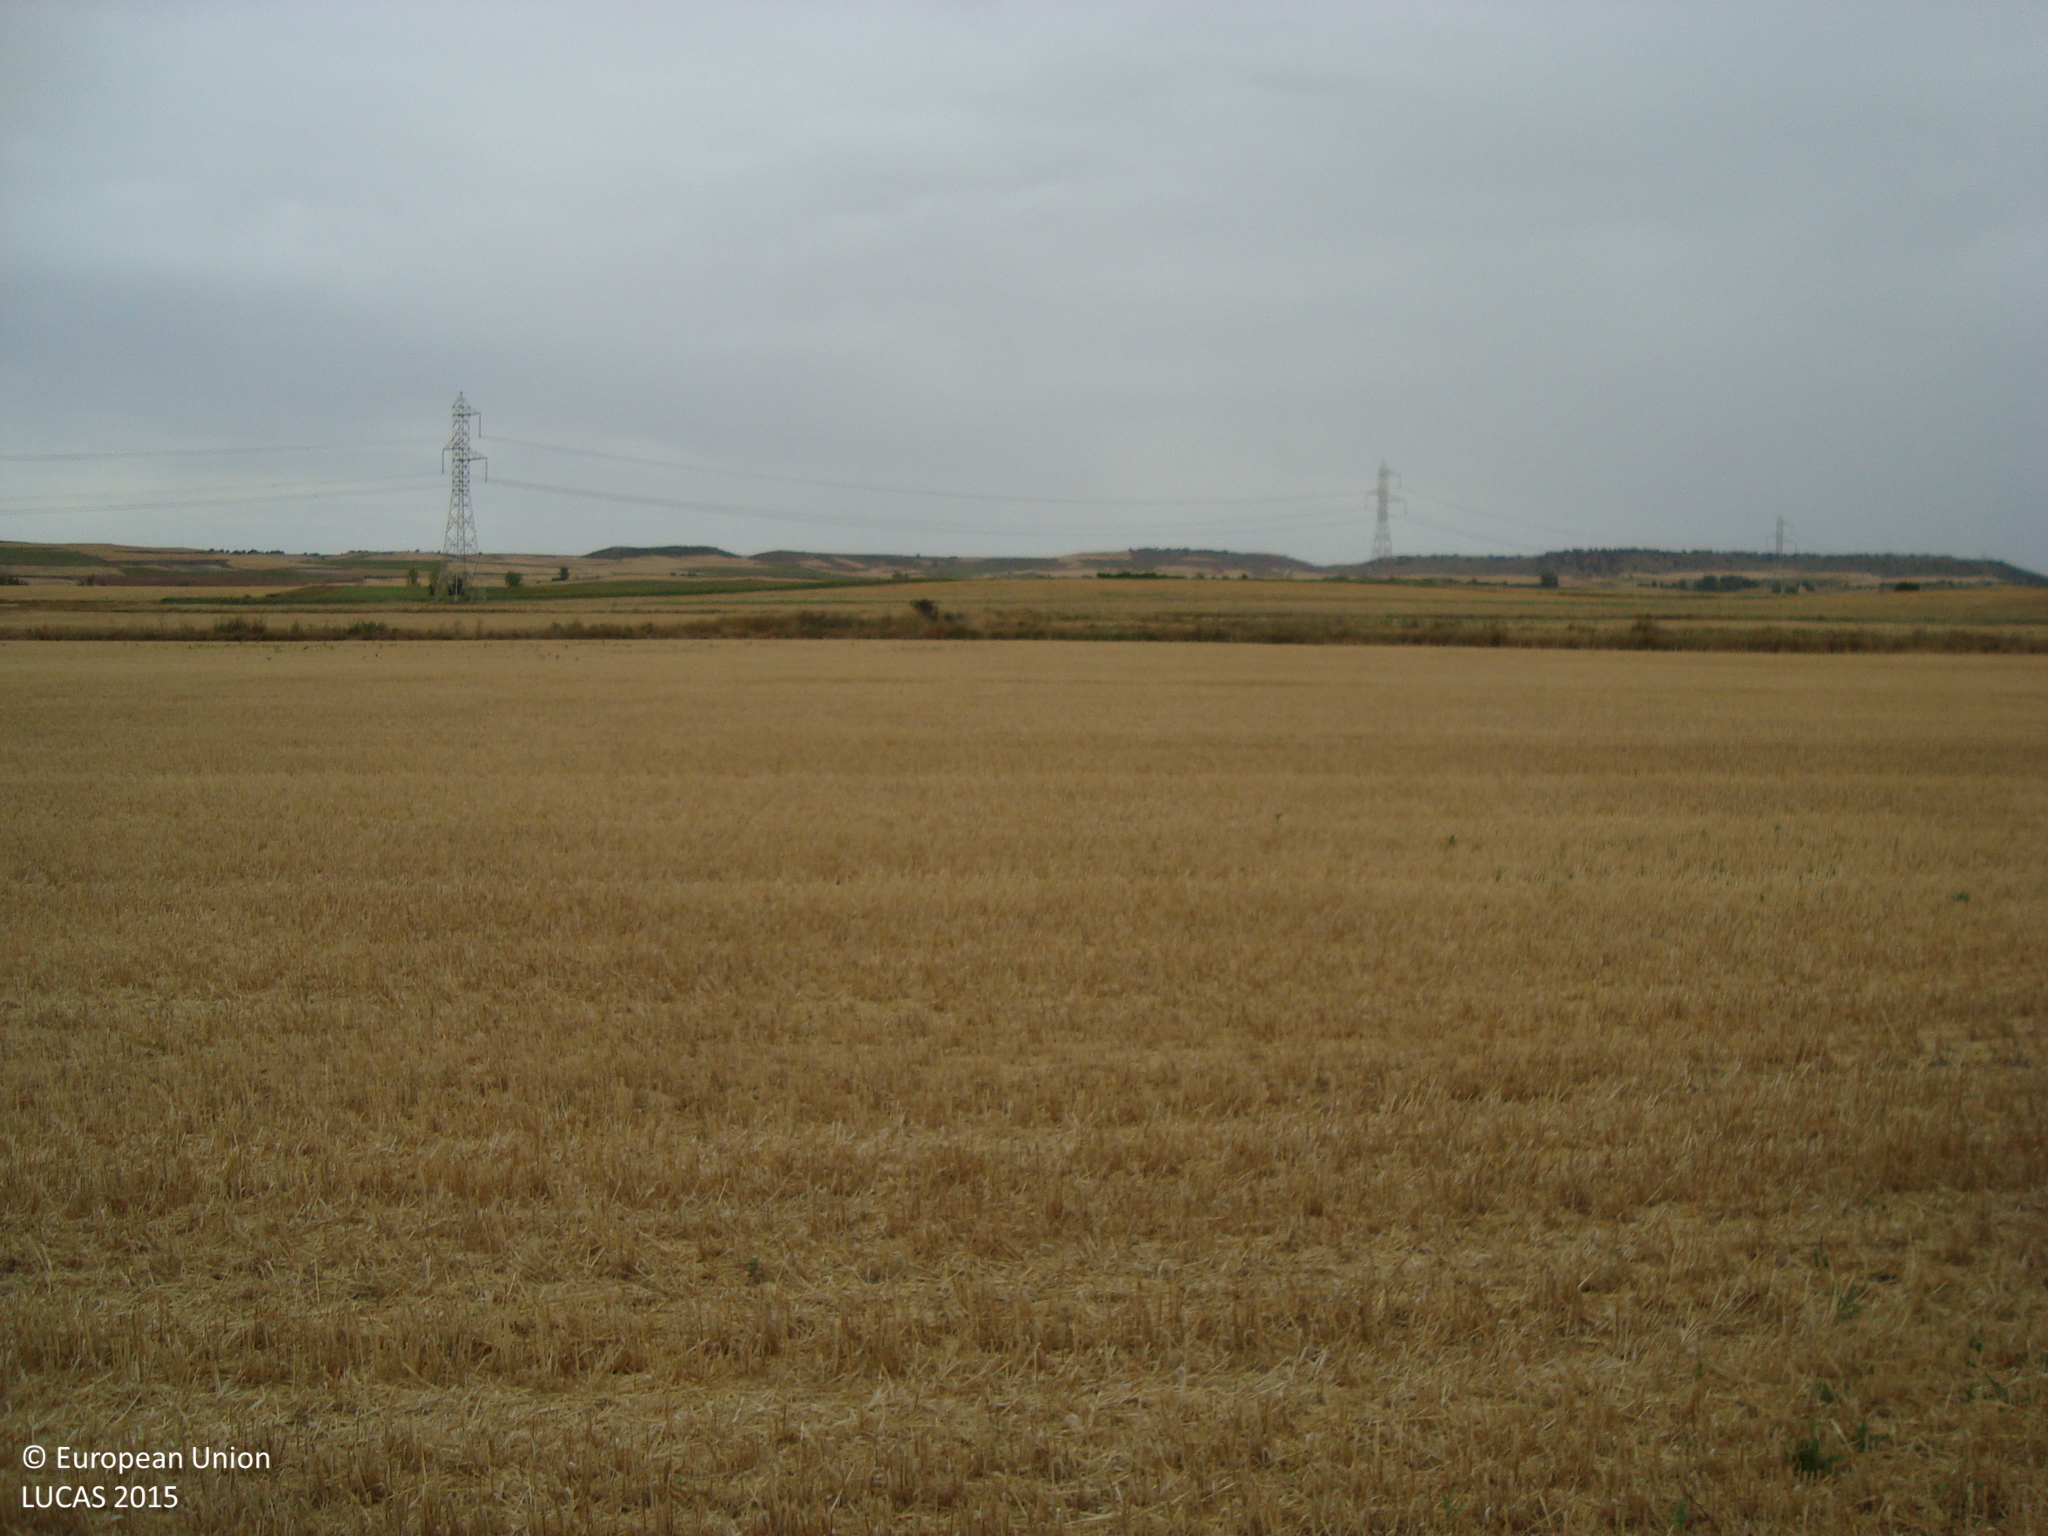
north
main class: Cropland
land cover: Barley
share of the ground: > 75 %
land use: Agriculture (excluding fallow land and kitchen gardens)
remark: Harvested field
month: August
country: ES
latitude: 42.1809
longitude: -3.9249
